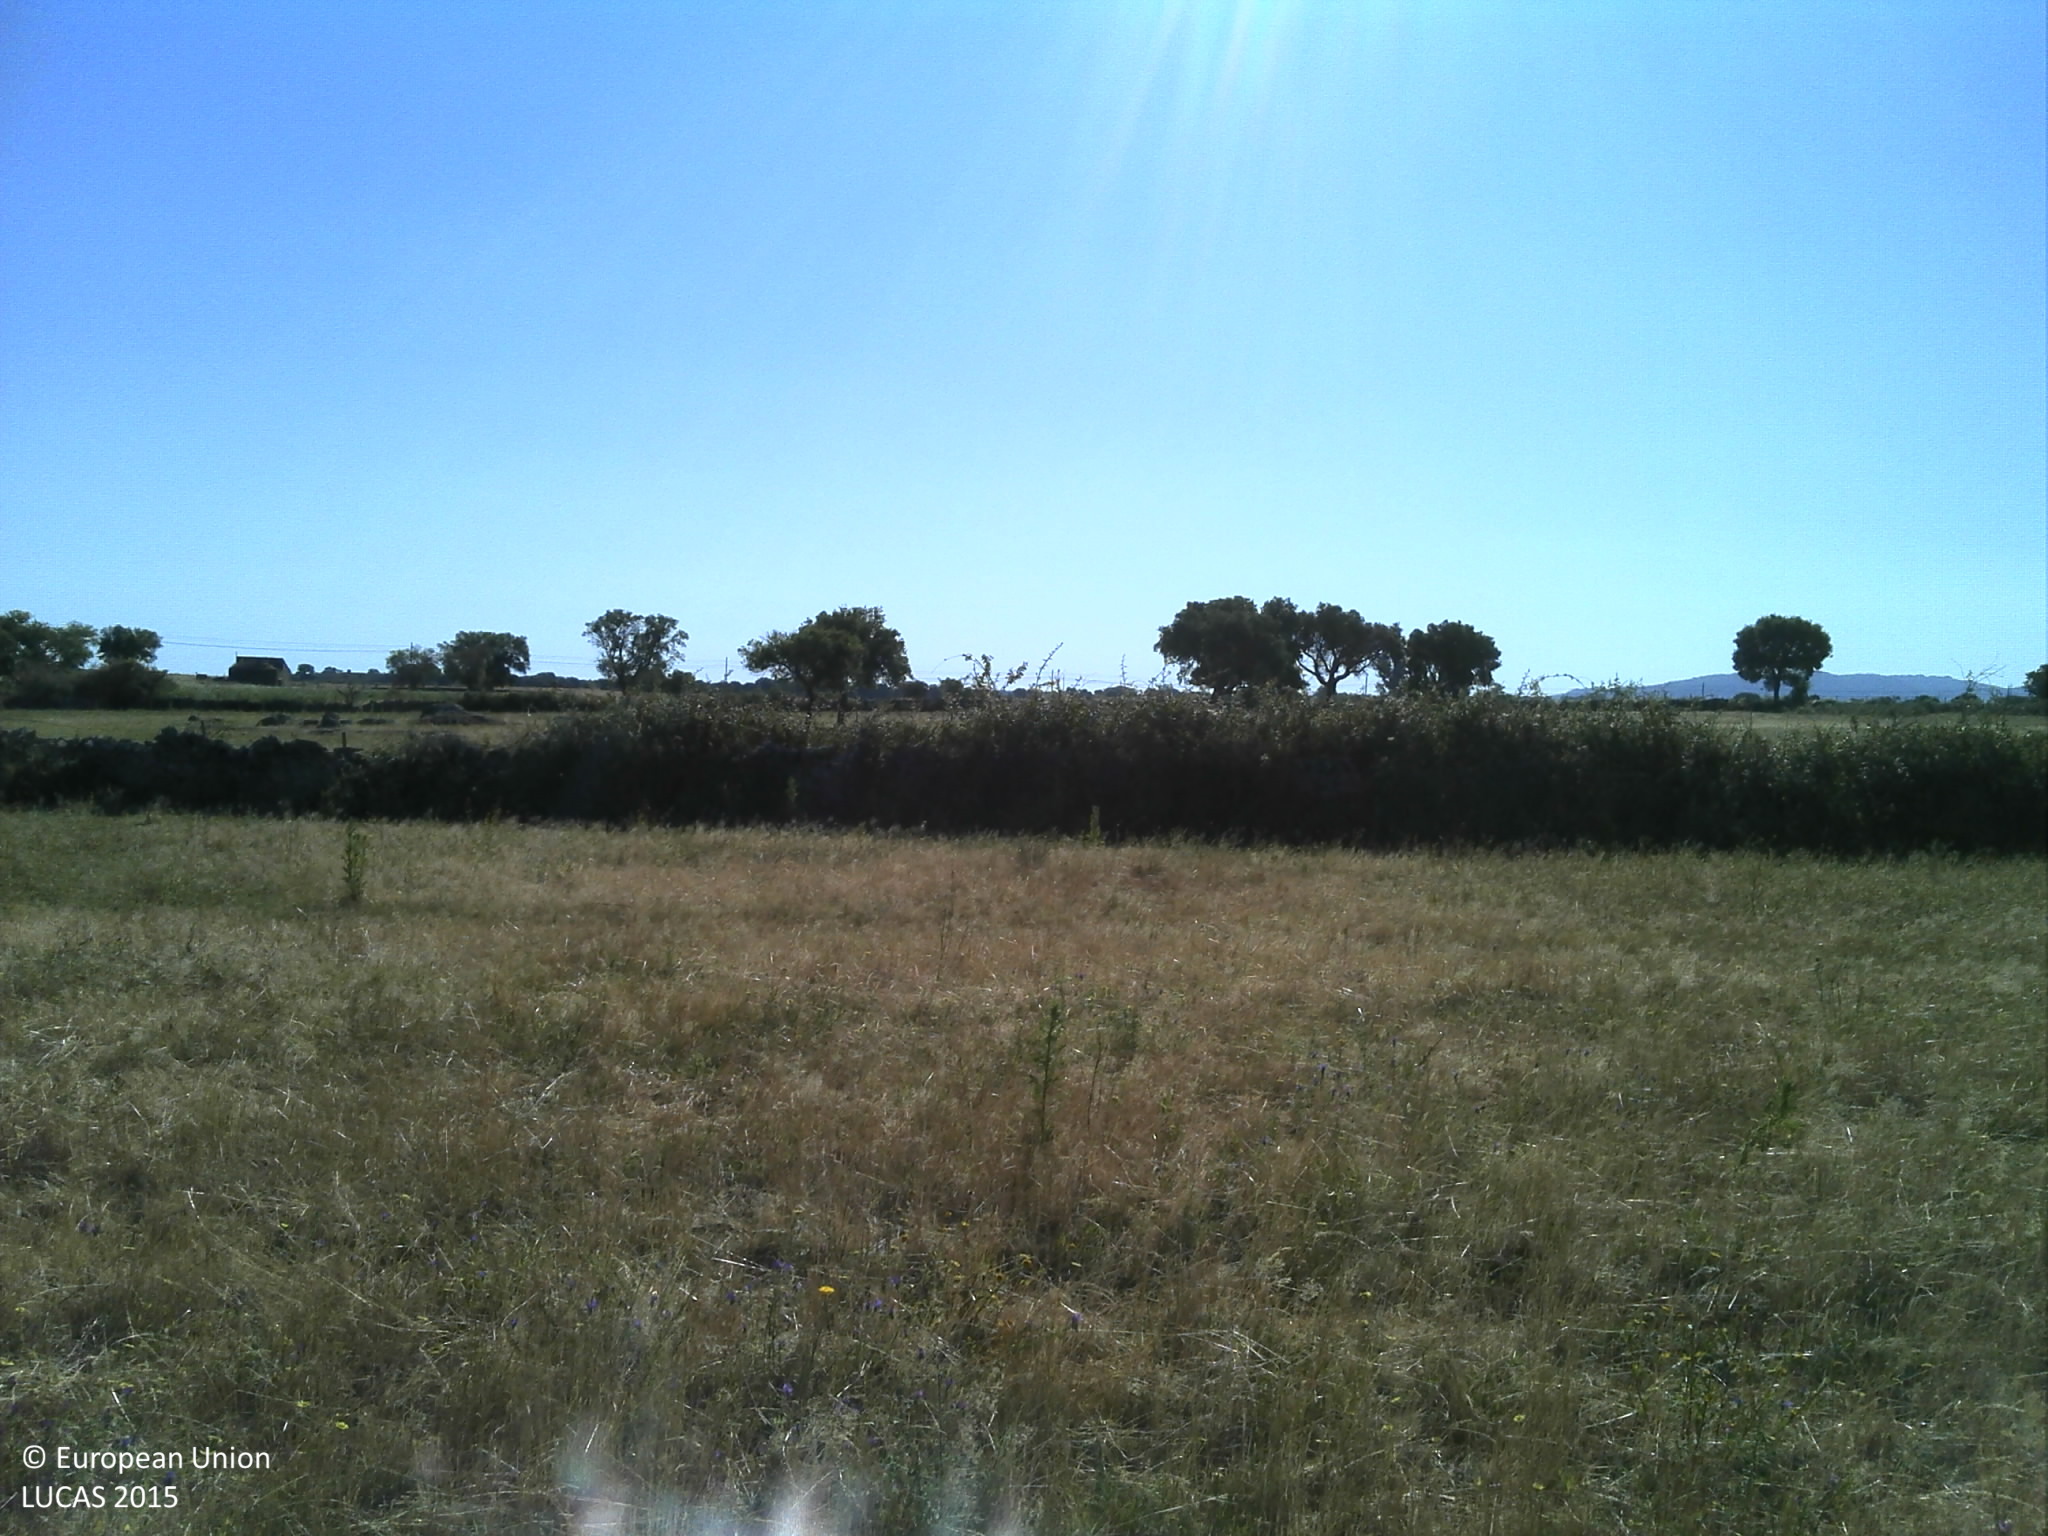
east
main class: Grassland
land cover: Grassland without tree/shrub cover
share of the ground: 50 - 75 %
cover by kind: herbaceous plants 75 %, unconsolidated bare surface 25 %
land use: Agriculture (excluding fallow land and kitchen gardens)
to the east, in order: Grassland without tree/shrub cover; Dry stone walls; Grassland without tree/shrub cover; Single bushes/trees; Fences; Dry stone walls; Grassland without tree/shrub cover
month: May
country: PT
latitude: 39.4328
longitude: -7.6263
